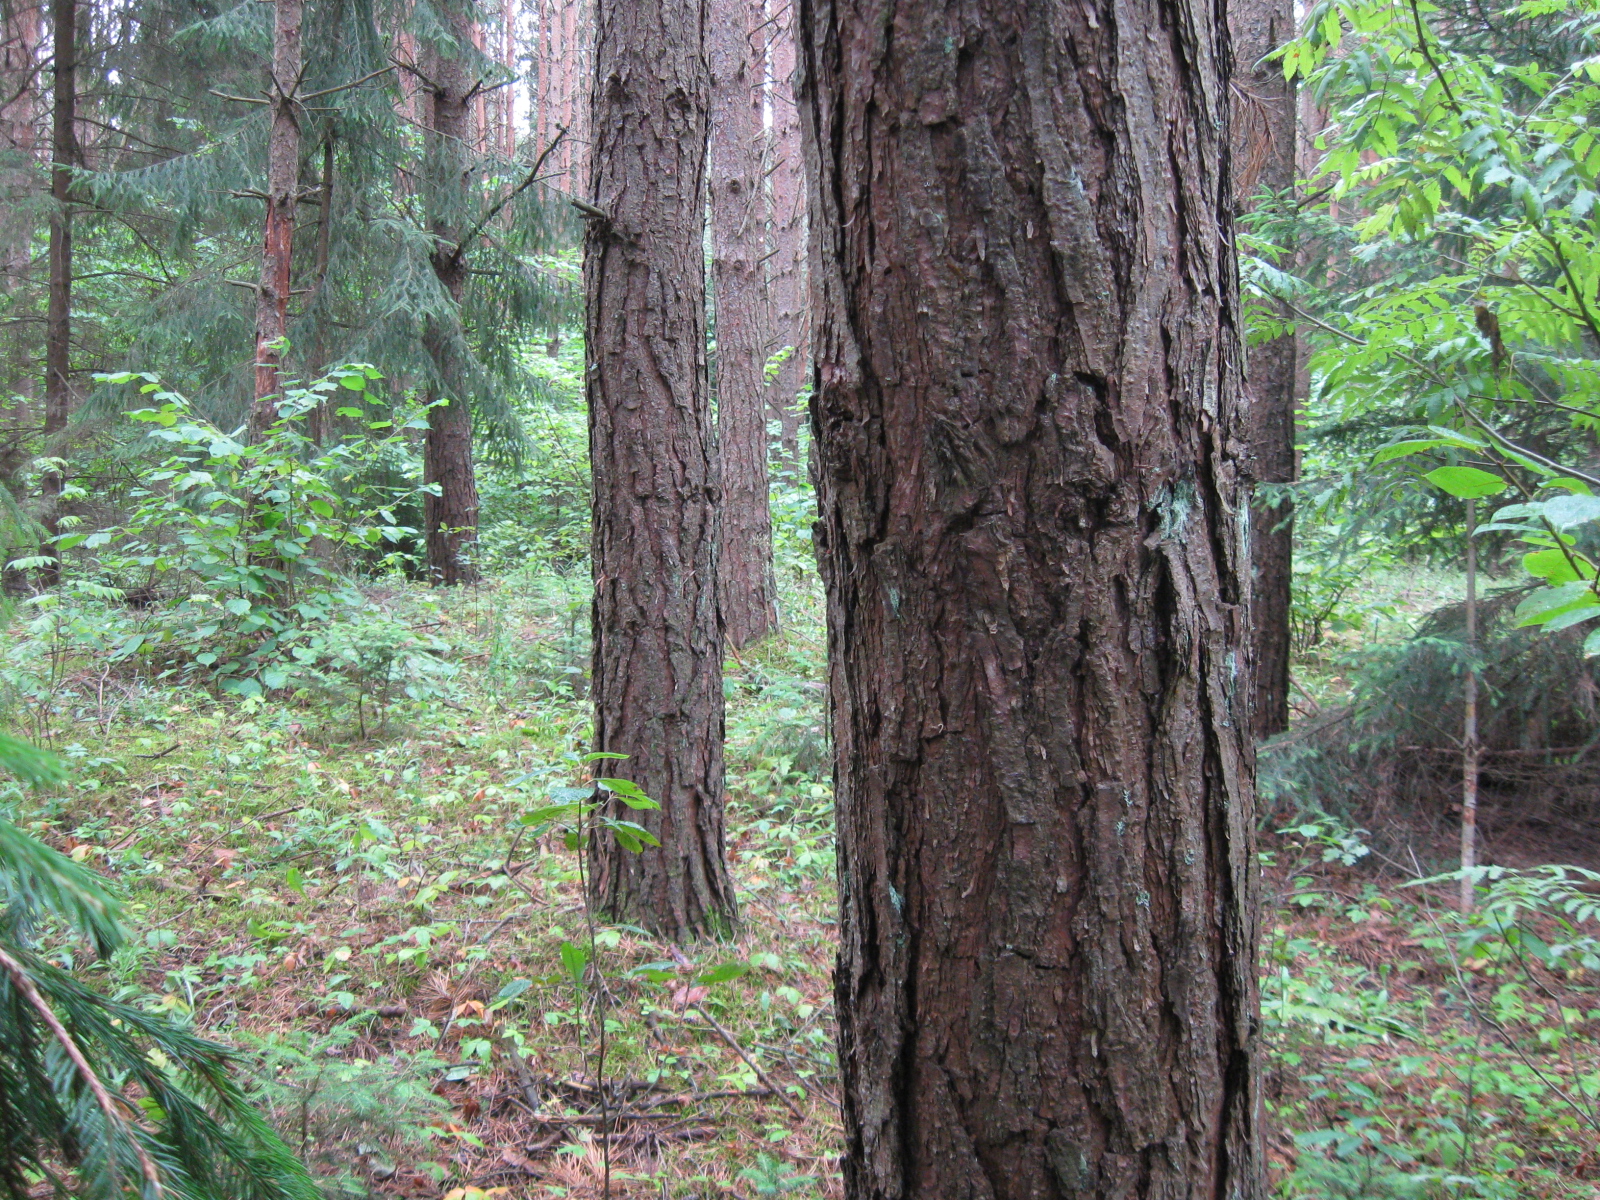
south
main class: Woodland
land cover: Pine dominated coniferous woodland
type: hemiboreal forest and nemoral coniferous forest and mixed broadleaved-coniferous forest
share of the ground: > 75 %
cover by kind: coniferous forest trees 90 %, broadleaved forest trees 5 %, herbaceous plants 5 %
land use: Forestry
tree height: > 5 m
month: July
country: LT
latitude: 54.2864
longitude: 24.2770
